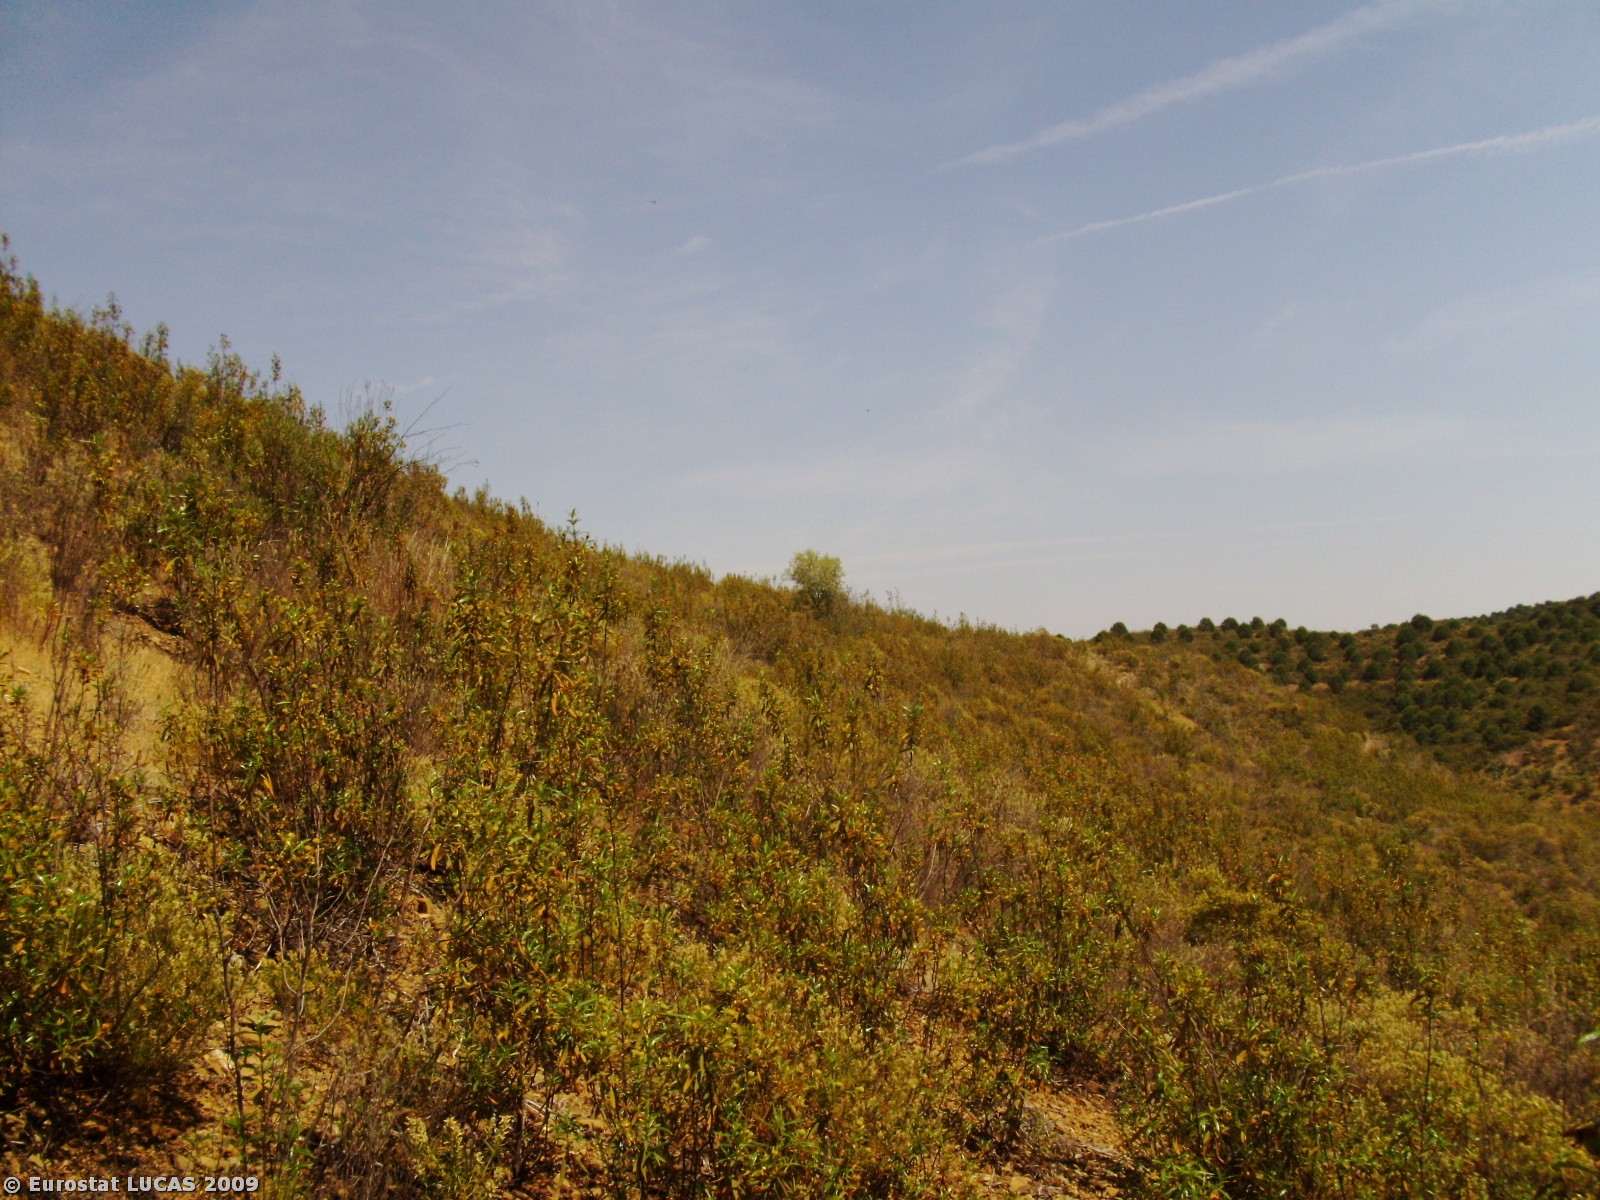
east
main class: Shrubland
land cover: Shrubland without tree cover
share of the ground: > 75 %
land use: Unused
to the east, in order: Shrubland without tree cover; Tracks; Spontaneously vegetated surfaces; Shrubland without tree cover
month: May
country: PT
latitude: 37.4574
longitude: -7.5204
